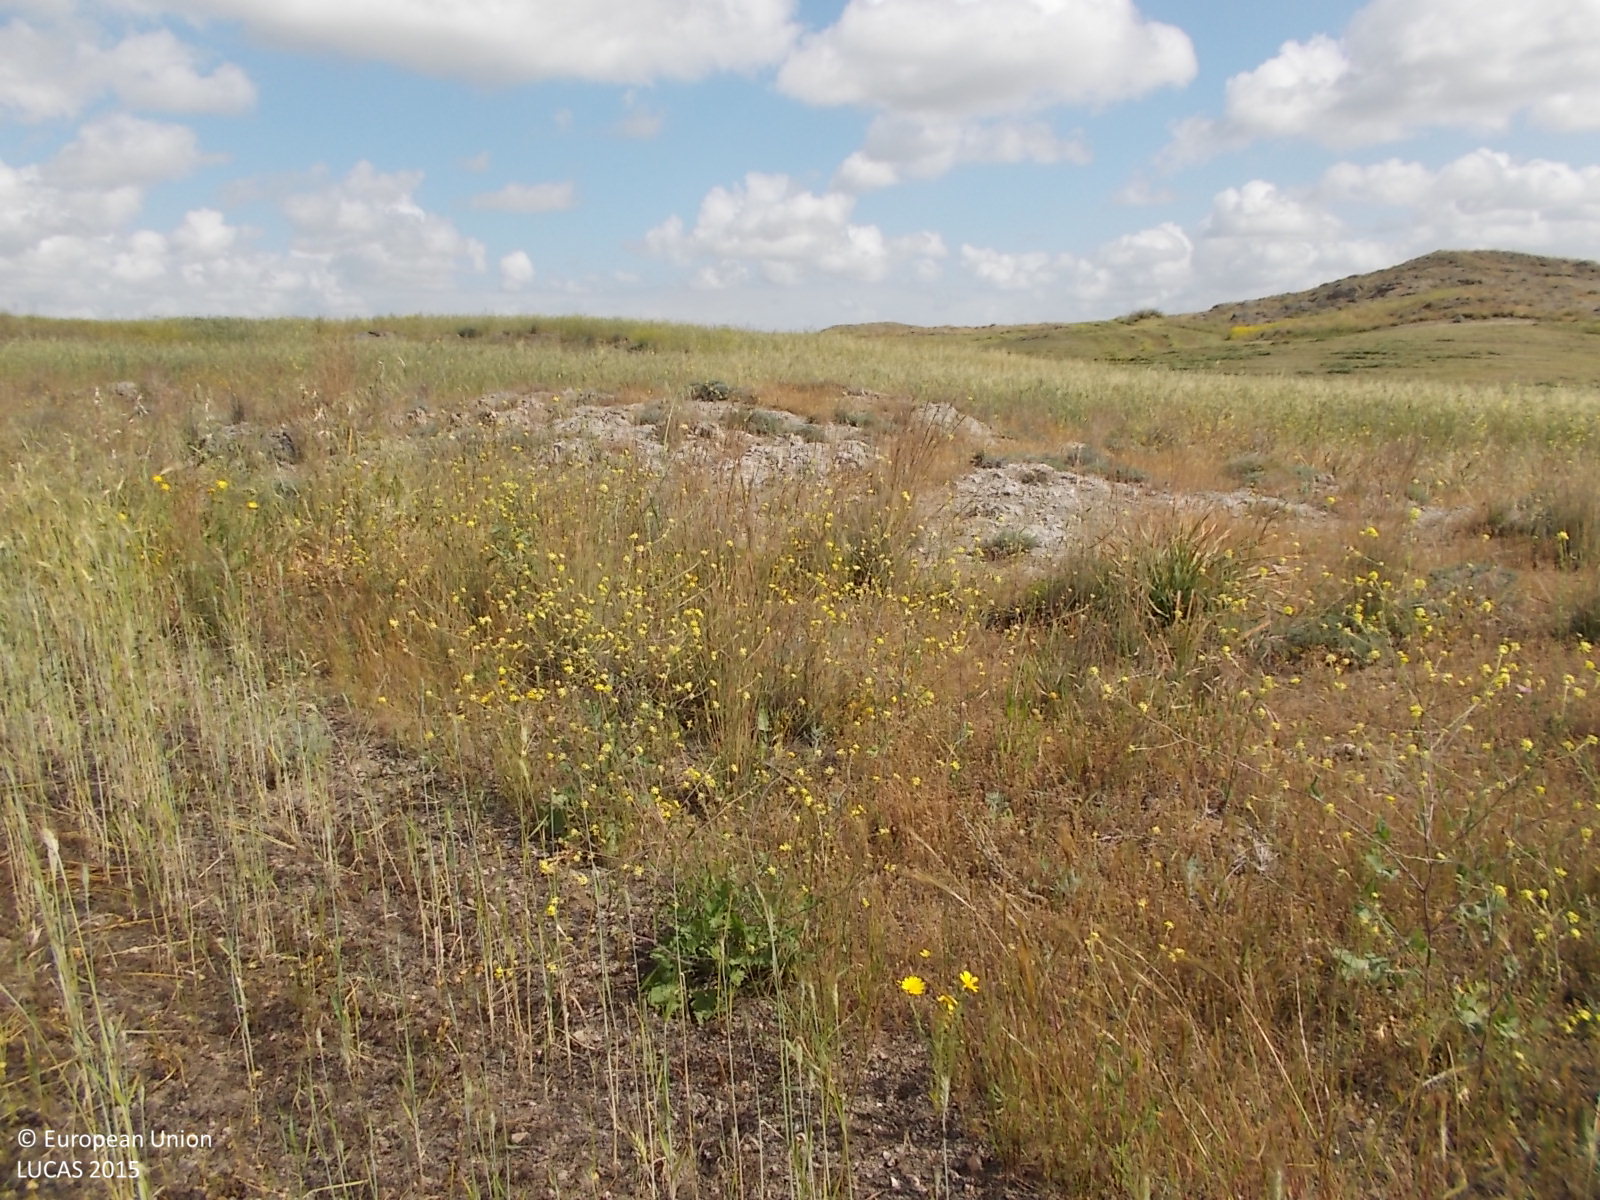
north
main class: Cropland
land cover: Common wheat
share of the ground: > 75 %
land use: Agriculture (excluding fallow land and kitchen gardens)
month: April
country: CY
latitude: 34.9979
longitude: 33.5896
